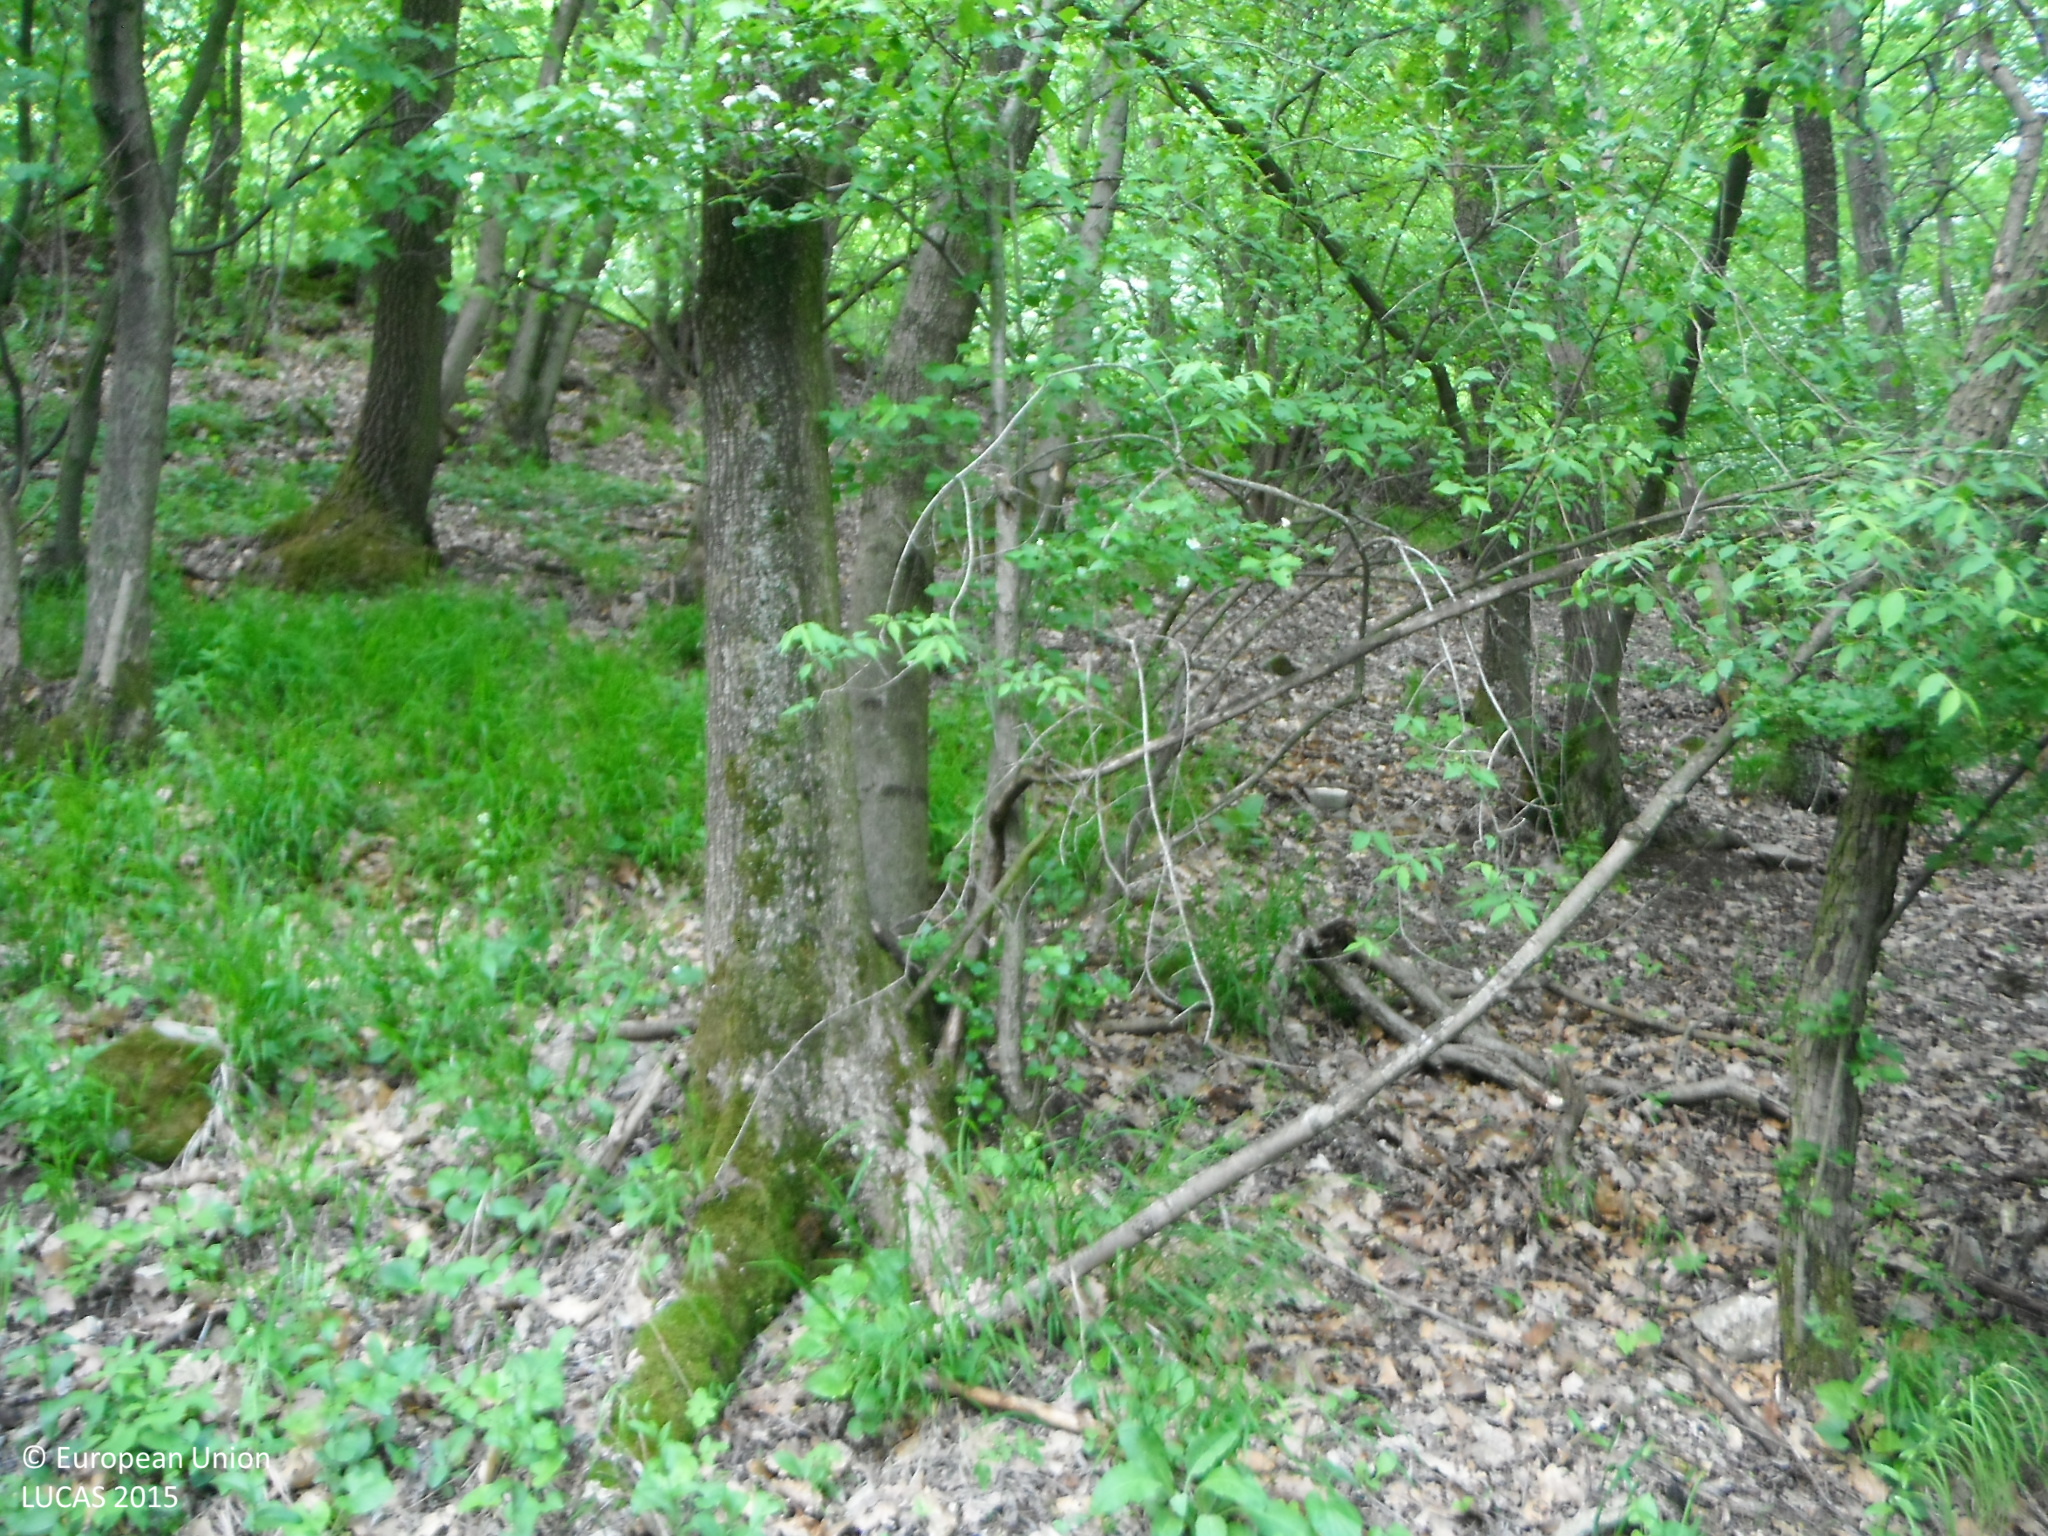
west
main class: Woodland
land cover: Broadleaved woodland
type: mesophytic deciduous forest
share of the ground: > 75 %
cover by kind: broadleaved forest trees 100 %
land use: Forestry
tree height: > 5 m
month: May
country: SK
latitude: 48.3593
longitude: 18.0982
